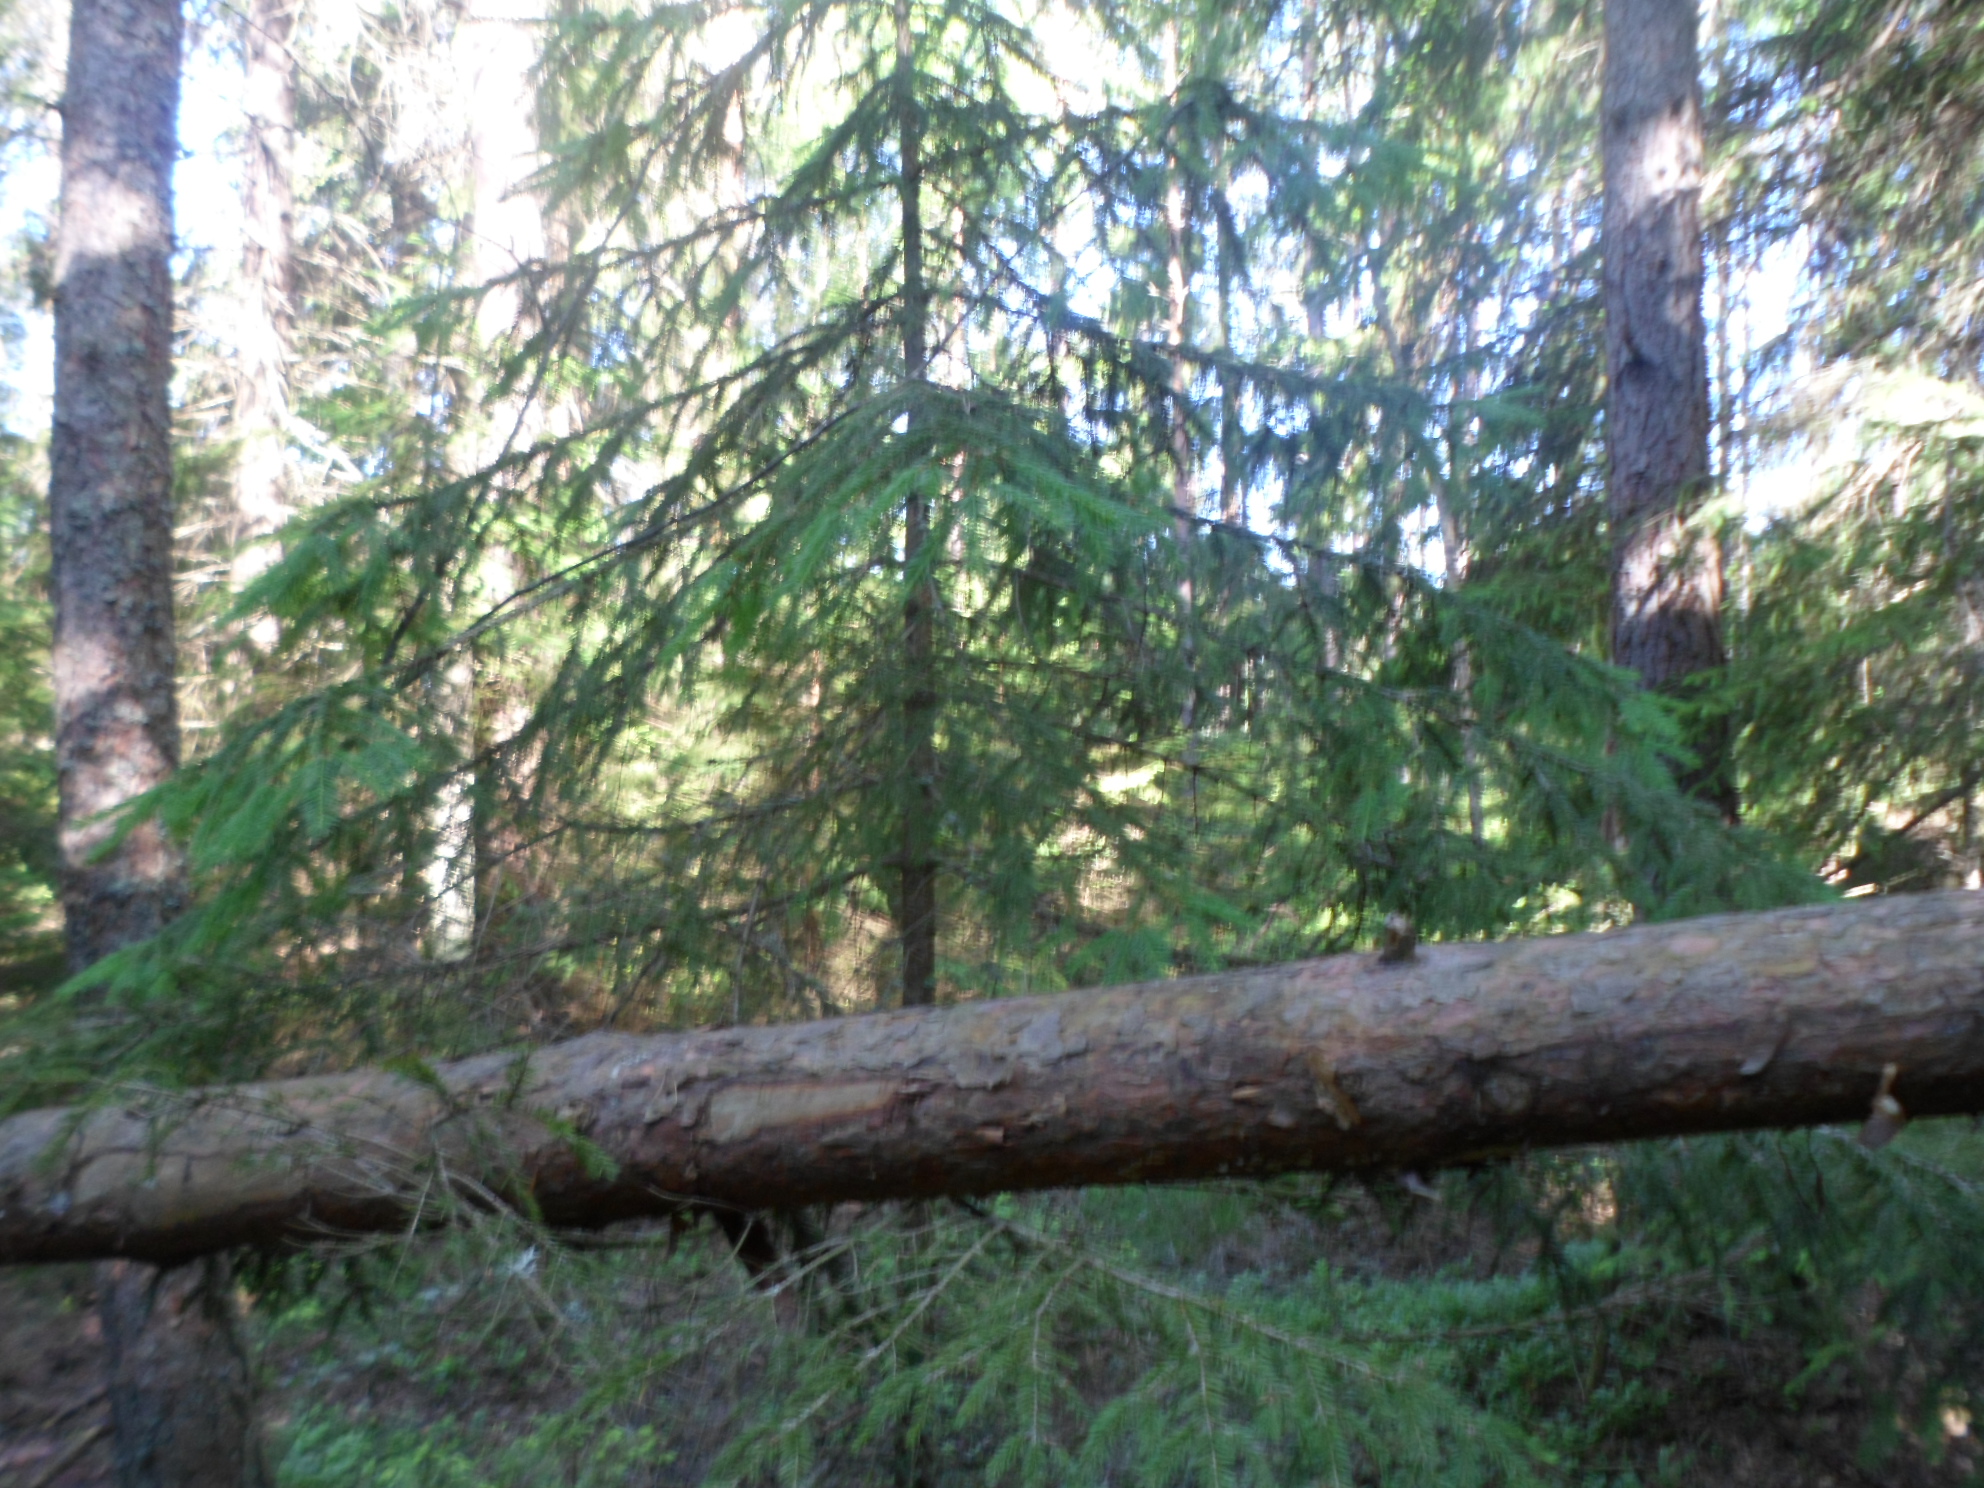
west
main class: Woodland
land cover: Spruce dominated mixed woodland
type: boreal forest
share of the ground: 50 - 75 %
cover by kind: coniferous forest trees 40 %, broadleaved forest trees 20 %, shrubs 20 %, herbaceous plants 10 %, lichens and mosses 10 %
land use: Forestry
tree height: > 5 m
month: July
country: SE
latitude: 57.2989
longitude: 14.4604
